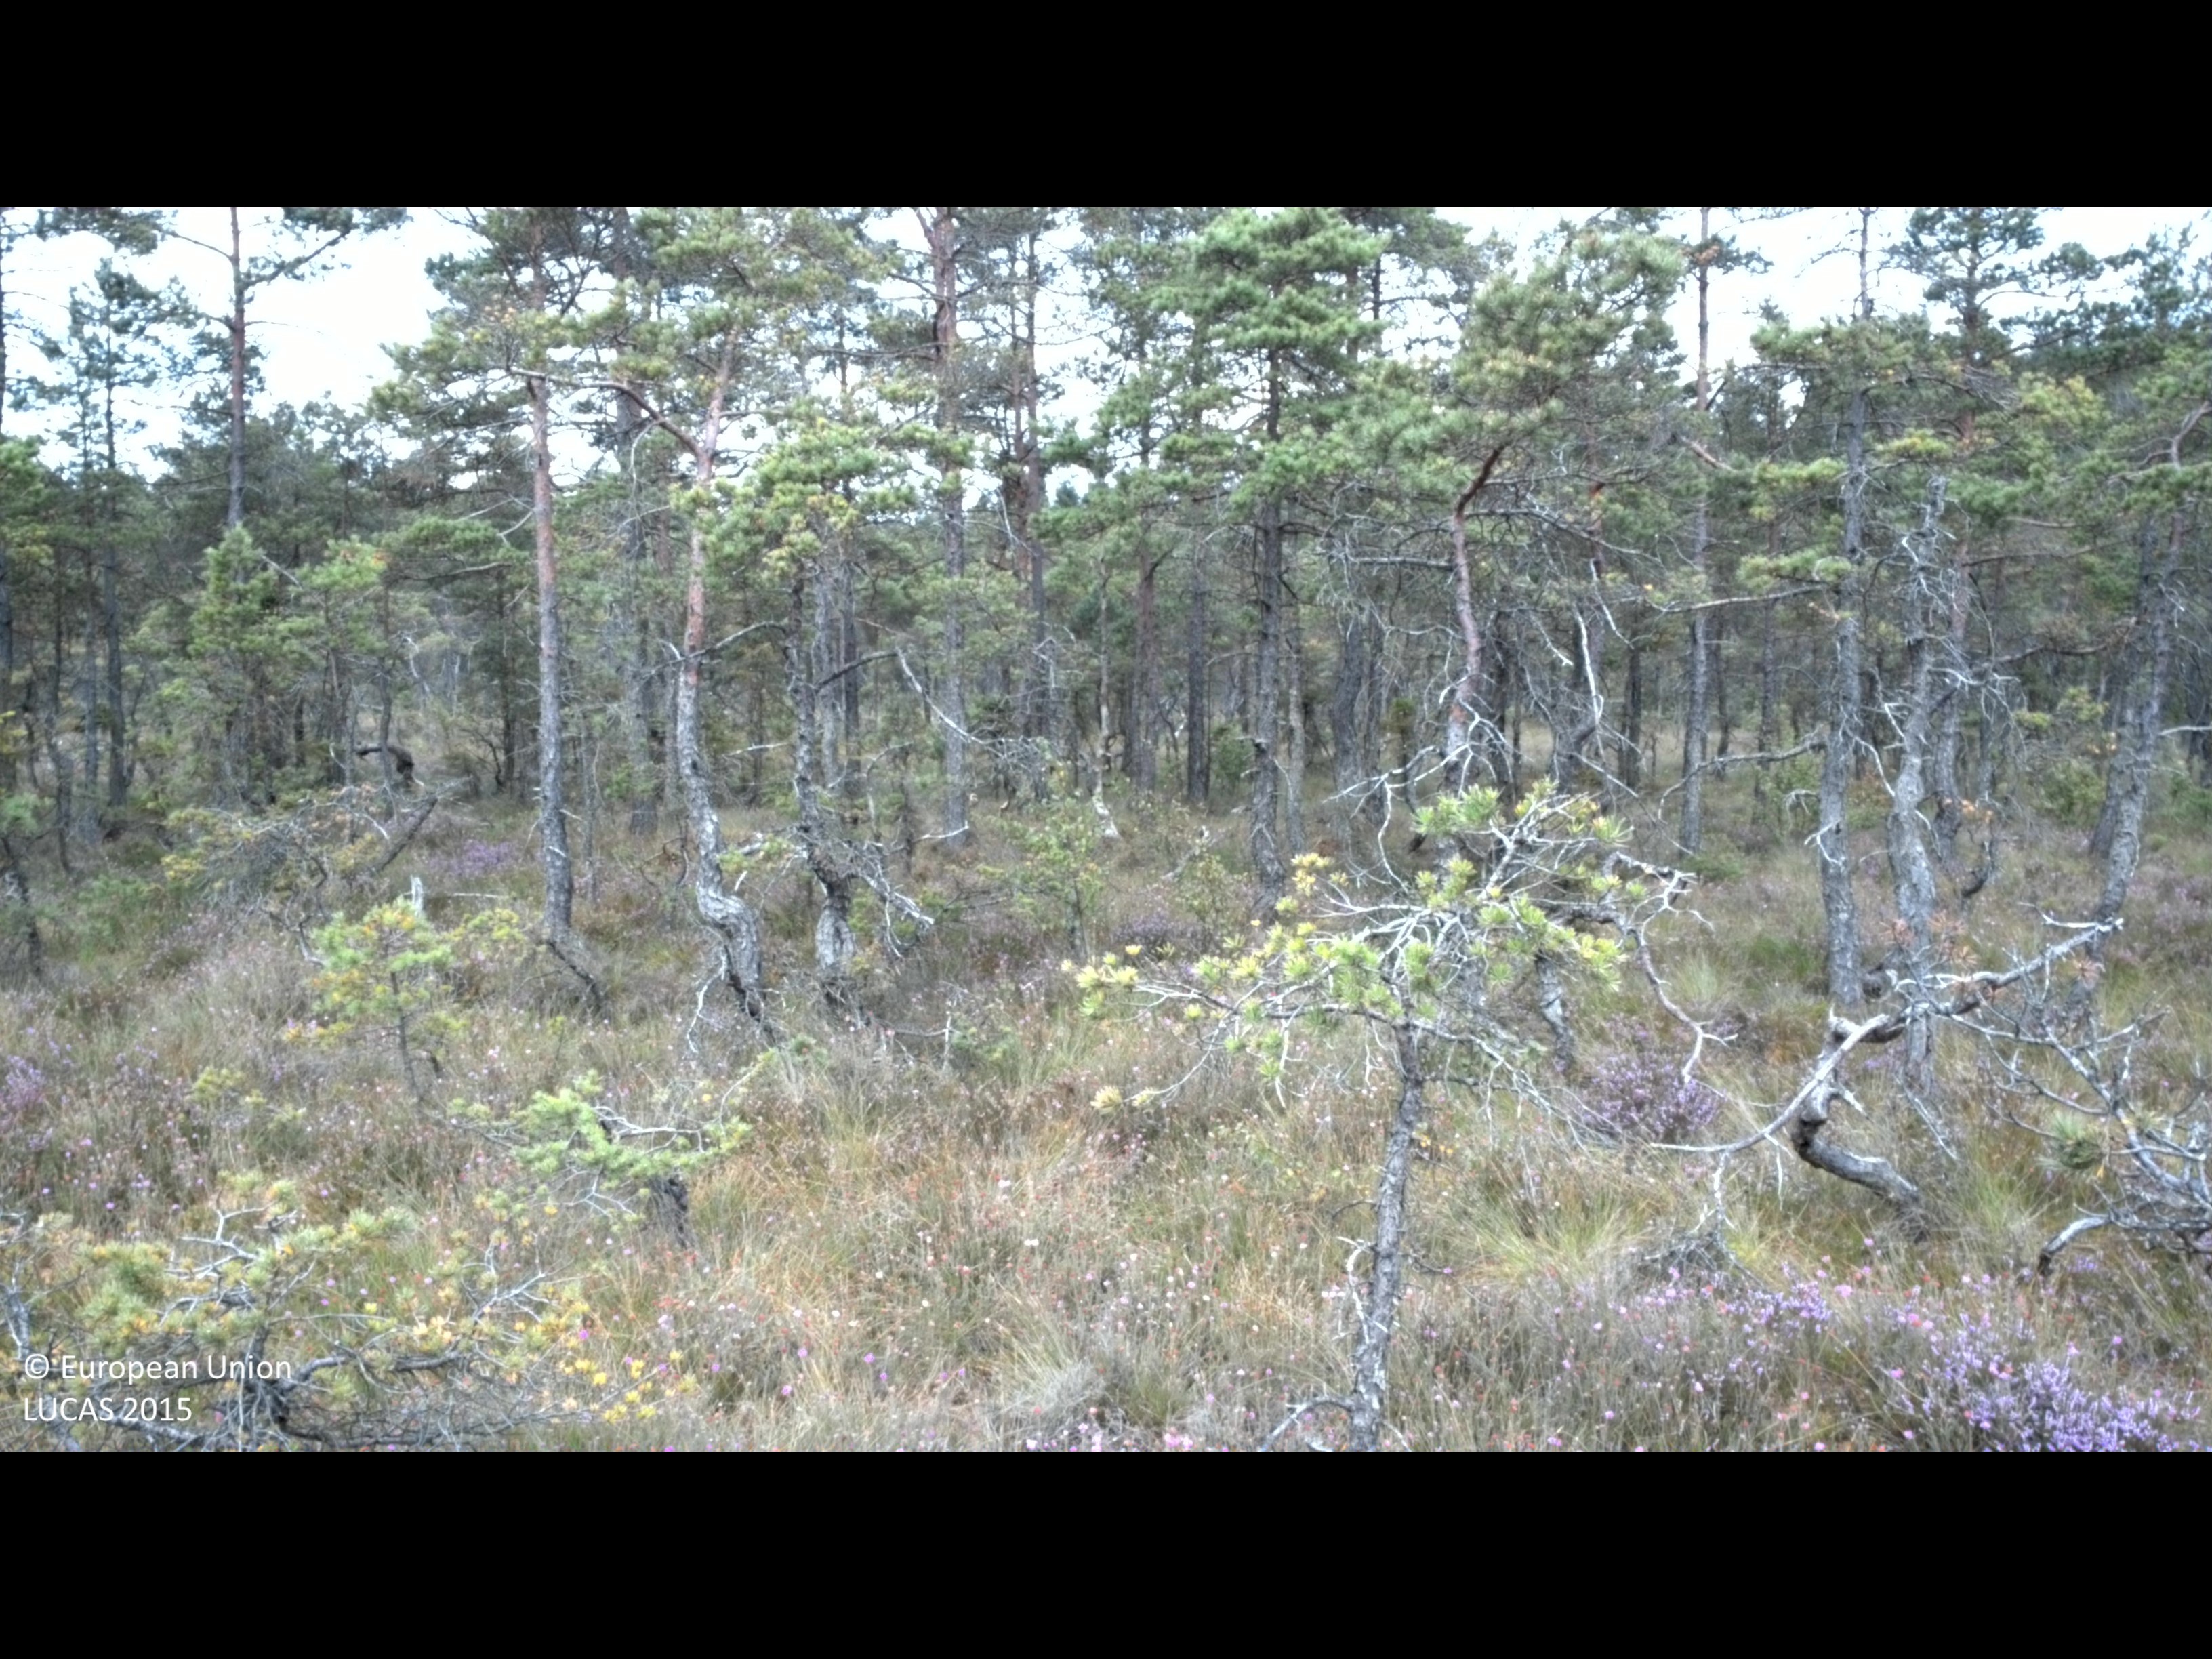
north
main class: Woodland
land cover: Pine dominated coniferous woodland
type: mire and swamp forests
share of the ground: 25 - 50 %
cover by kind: coniferous forest trees 40 %, shrubs 30 %, herbaceous plants 30 %
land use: Semi-natural and natural areas not in use
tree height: < 5 m
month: August
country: SE
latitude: 56.8677
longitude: 13.1954
